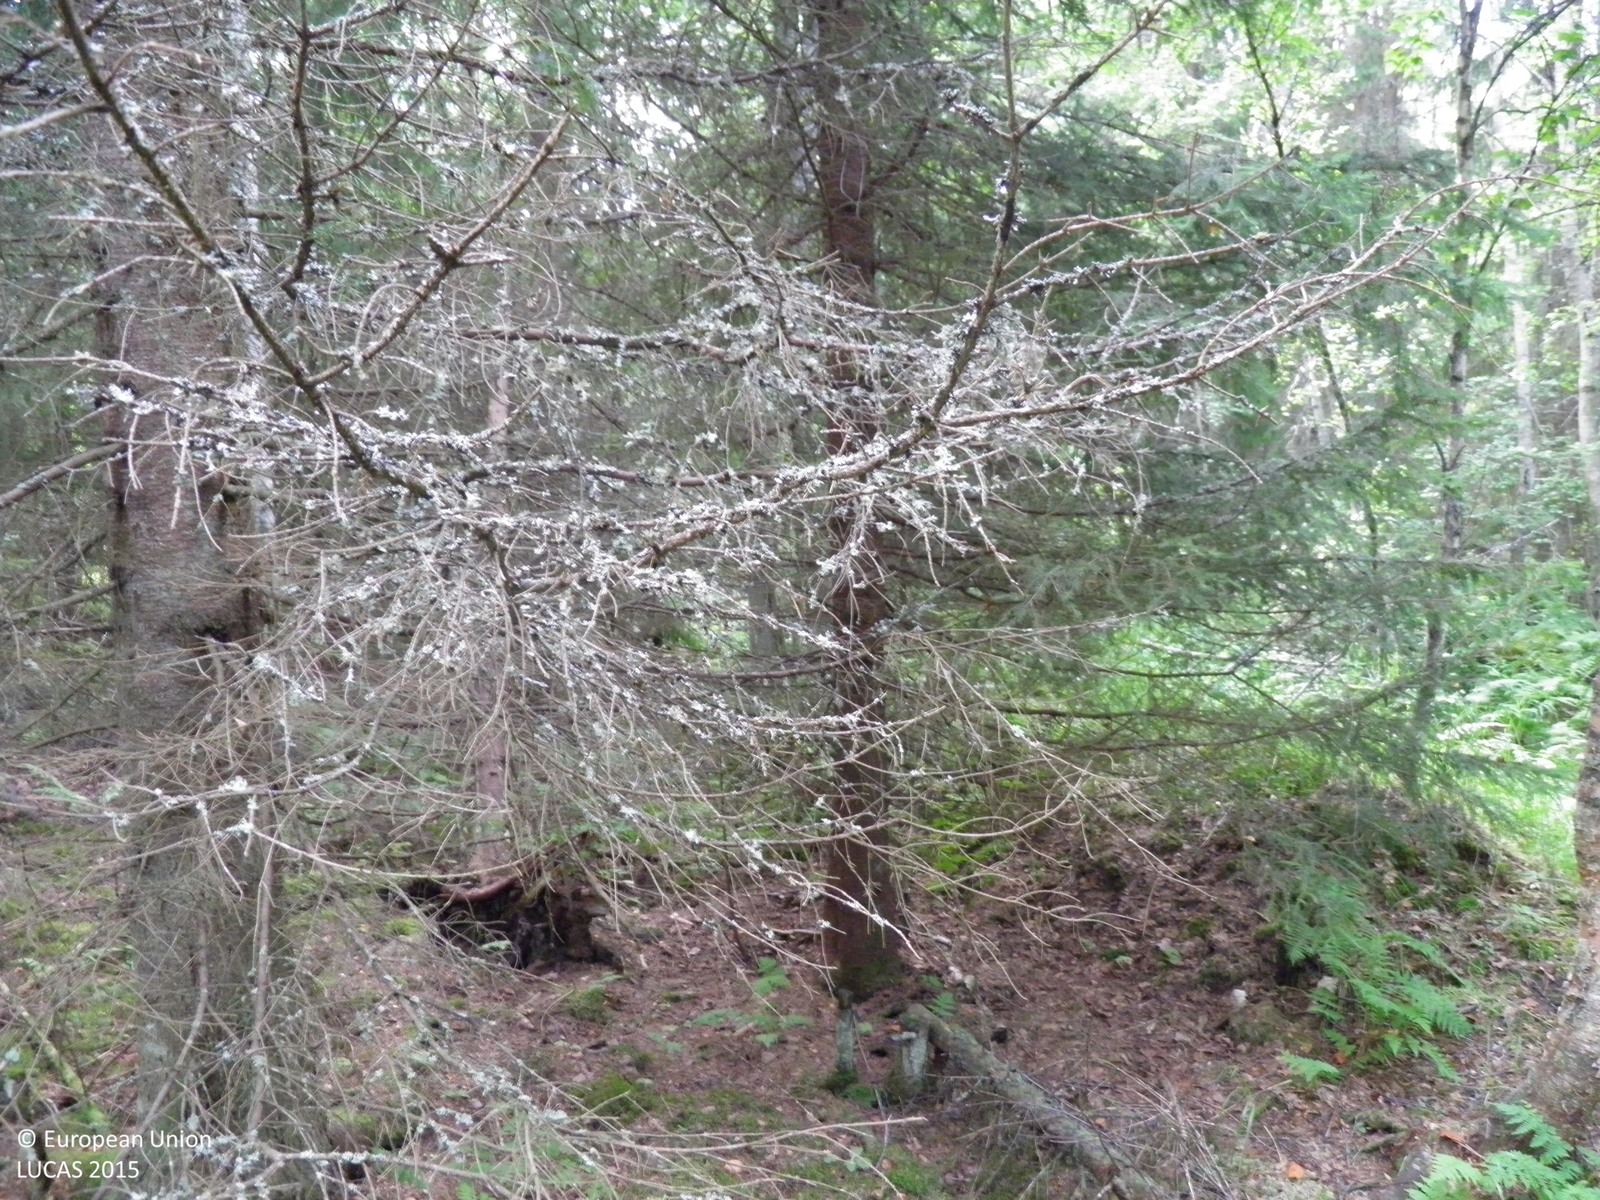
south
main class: Woodland
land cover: Spruce dominated mixed woodland
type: hemiboreal forest and nemoral coniferous forest and mixed broadleaved-coniferous forest
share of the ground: 50 - 75 %
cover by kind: coniferous forest trees 40 %, broadleaved forest trees 30 %, shrubs 15 %, lichens and mosses 15 %
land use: Forestry
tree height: > 5 m
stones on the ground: < 10 %
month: August
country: FI
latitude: 60.9158
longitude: 22.7408
